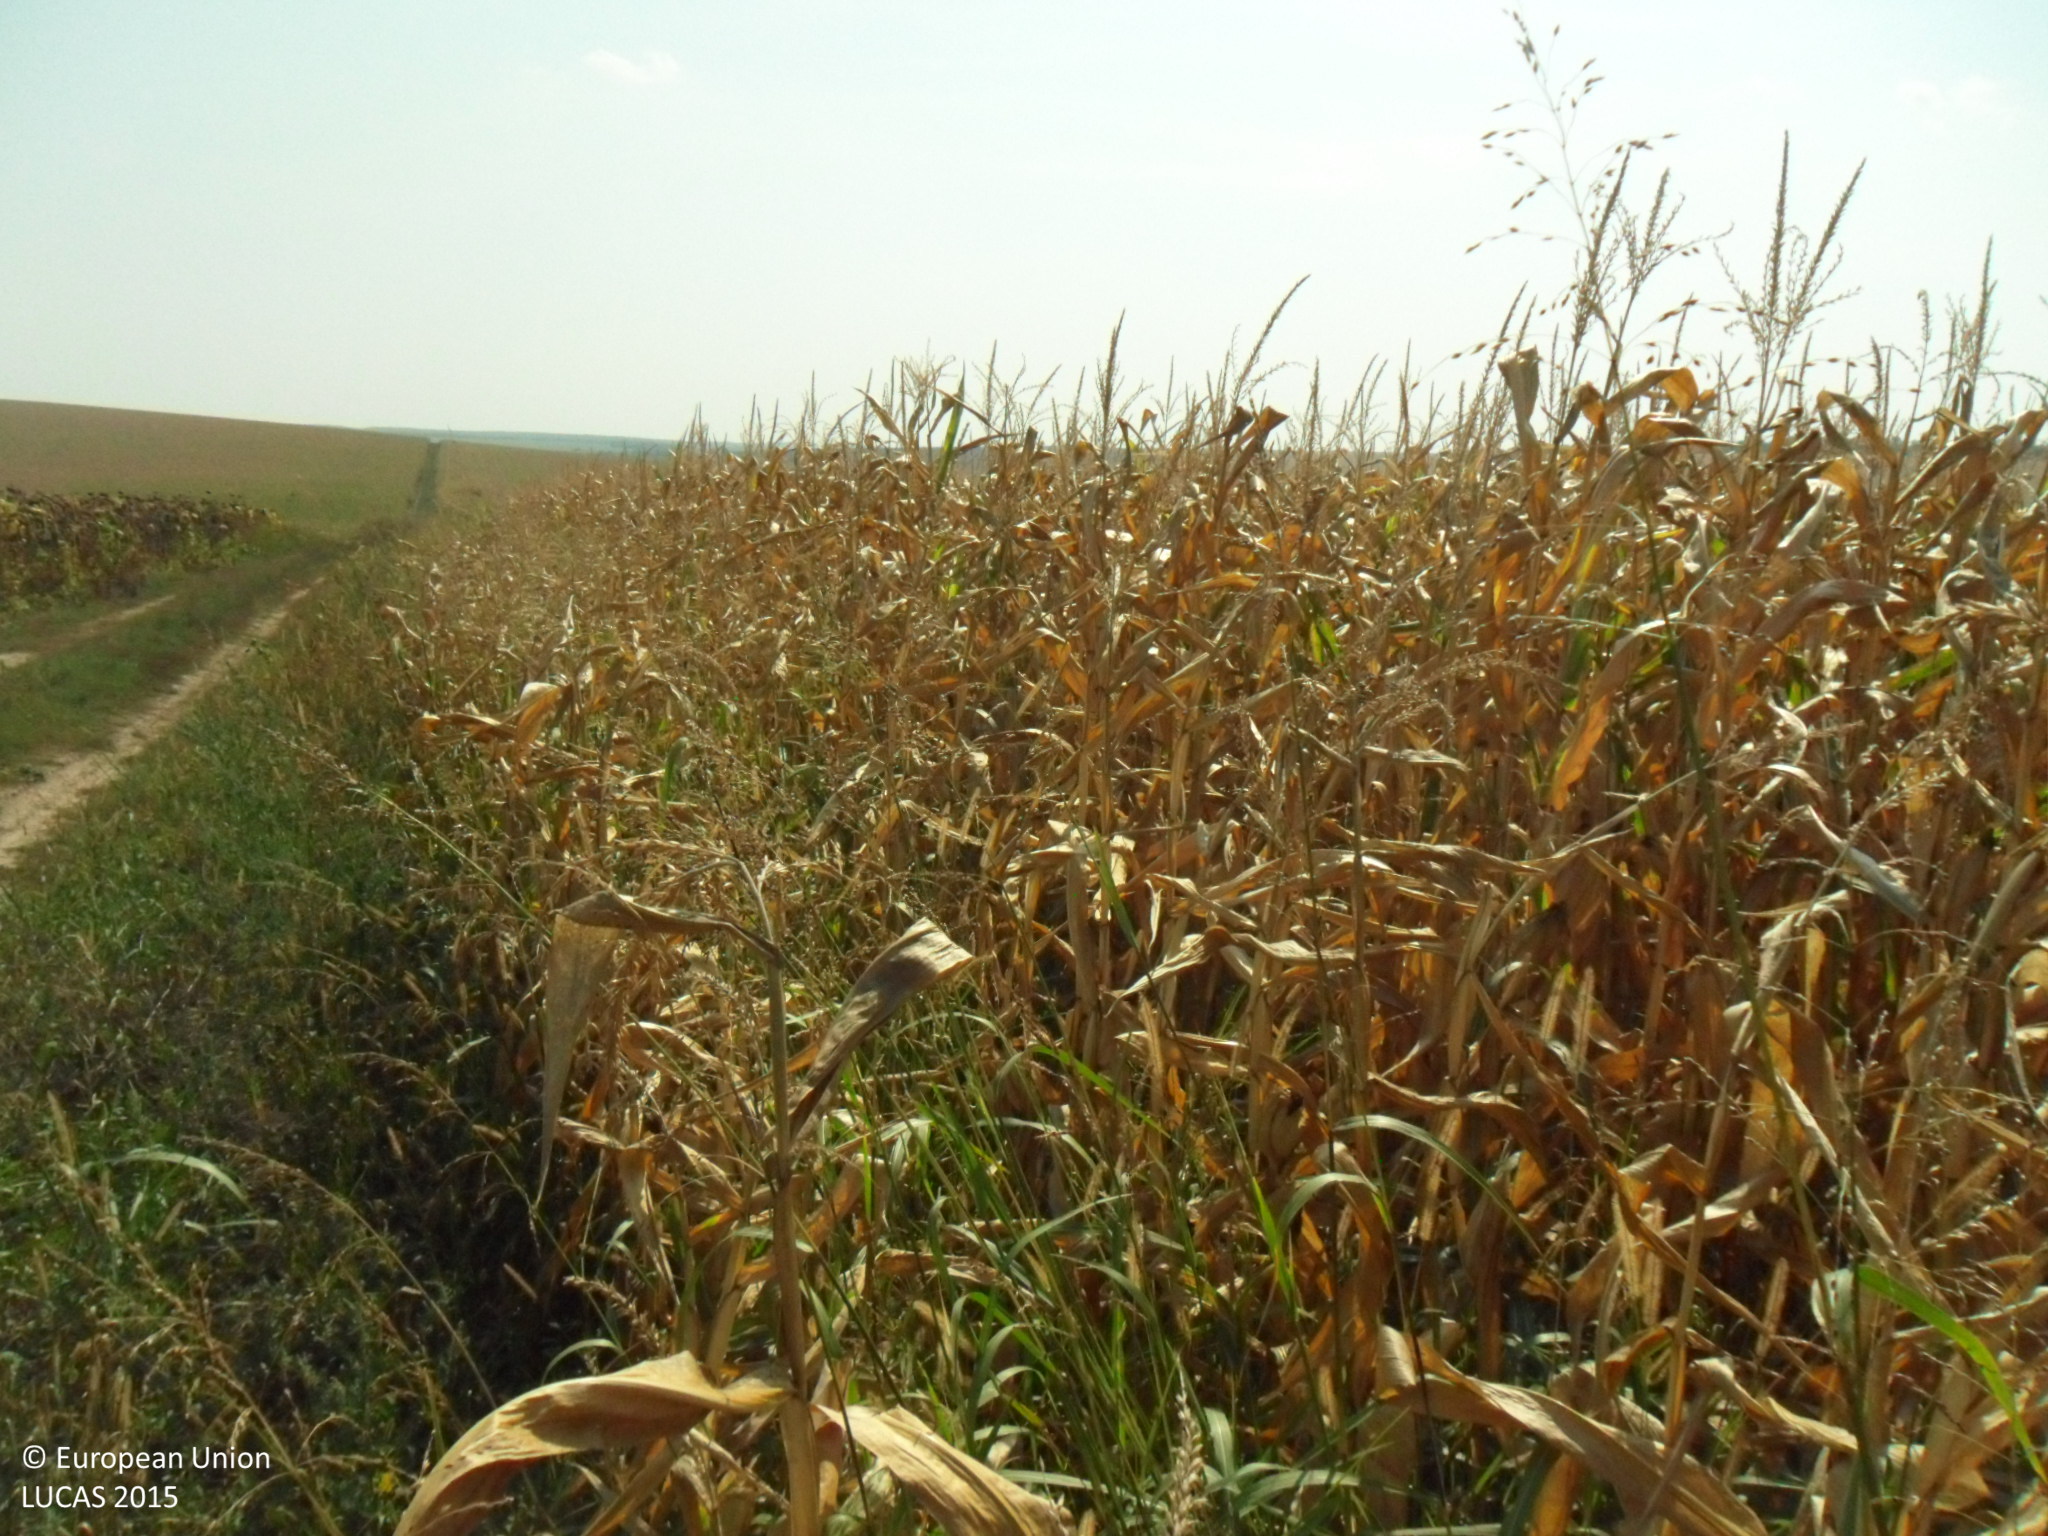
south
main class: Cropland
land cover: Maize
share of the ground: > 75 %
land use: Agriculture (excluding fallow land and kitchen gardens)
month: September
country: BG
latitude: 43.6345
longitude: 26.5558
